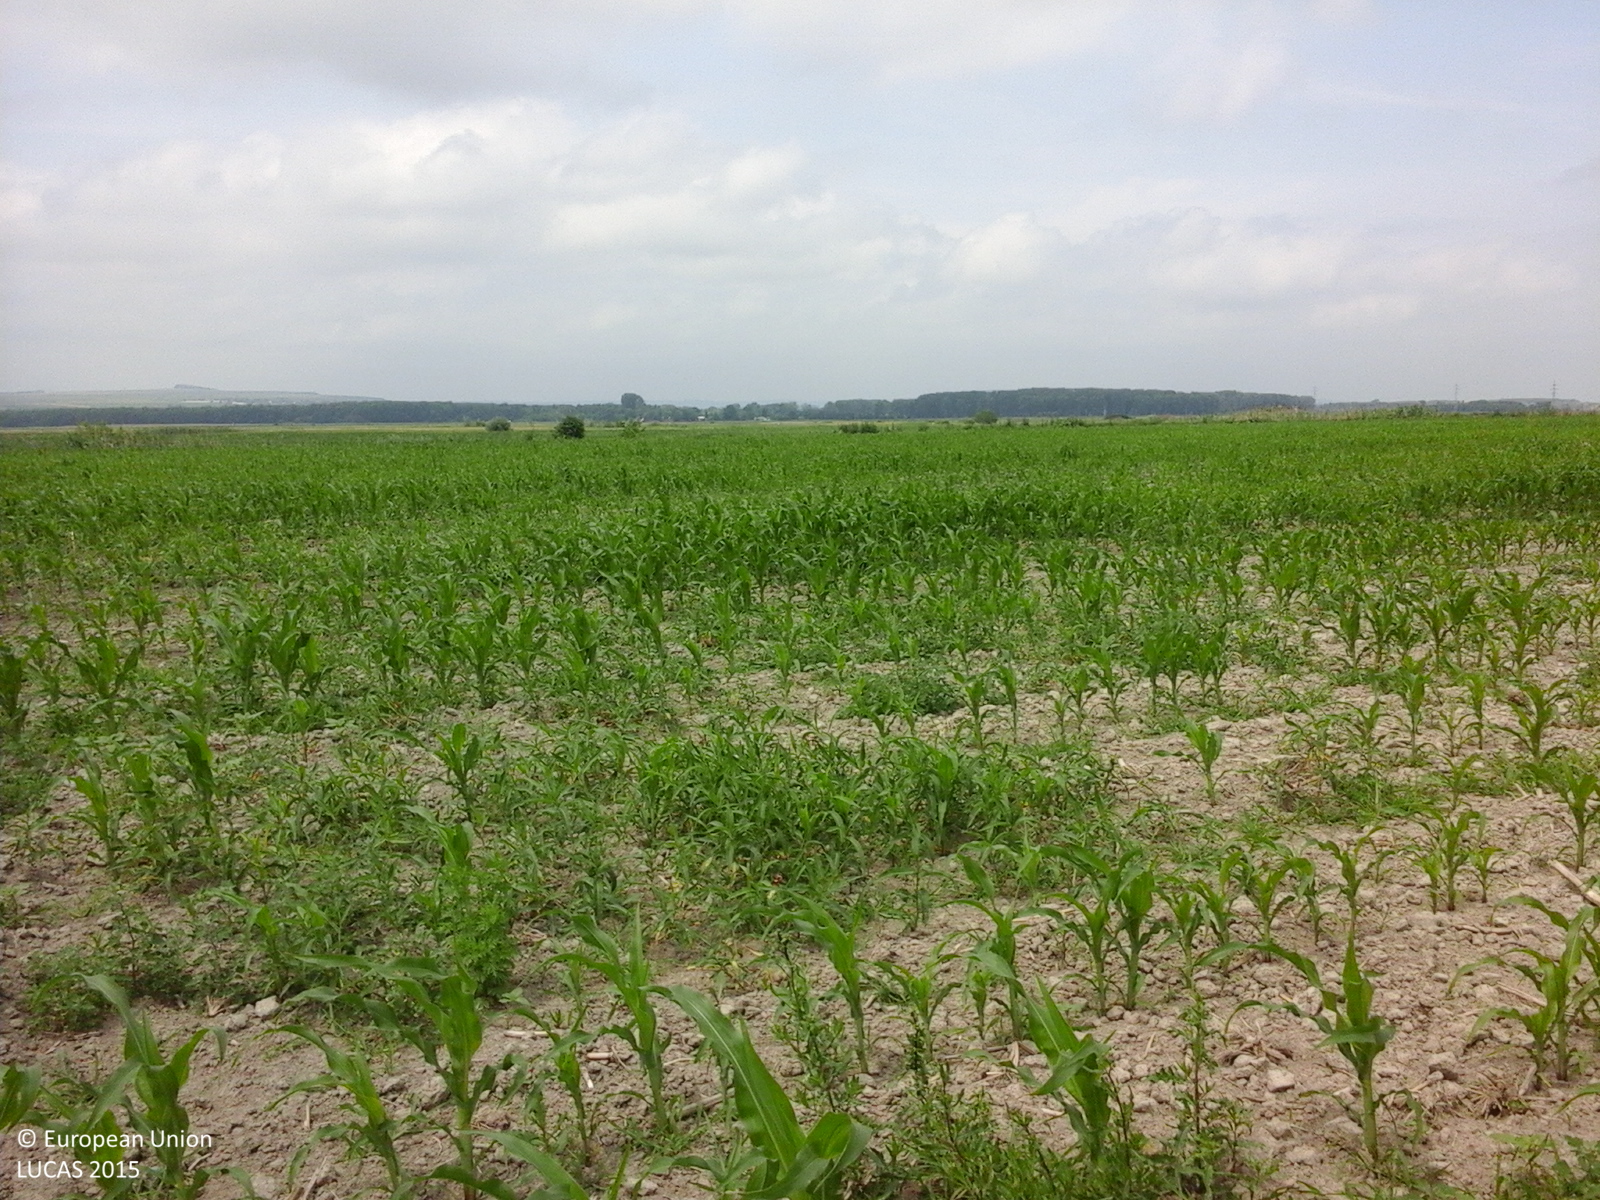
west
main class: Cropland
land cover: Maize
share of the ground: 50 - 75 %
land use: Agriculture (excluding fallow land and kitchen gardens)
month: June
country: RO
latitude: 47.7510
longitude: 26.4285
